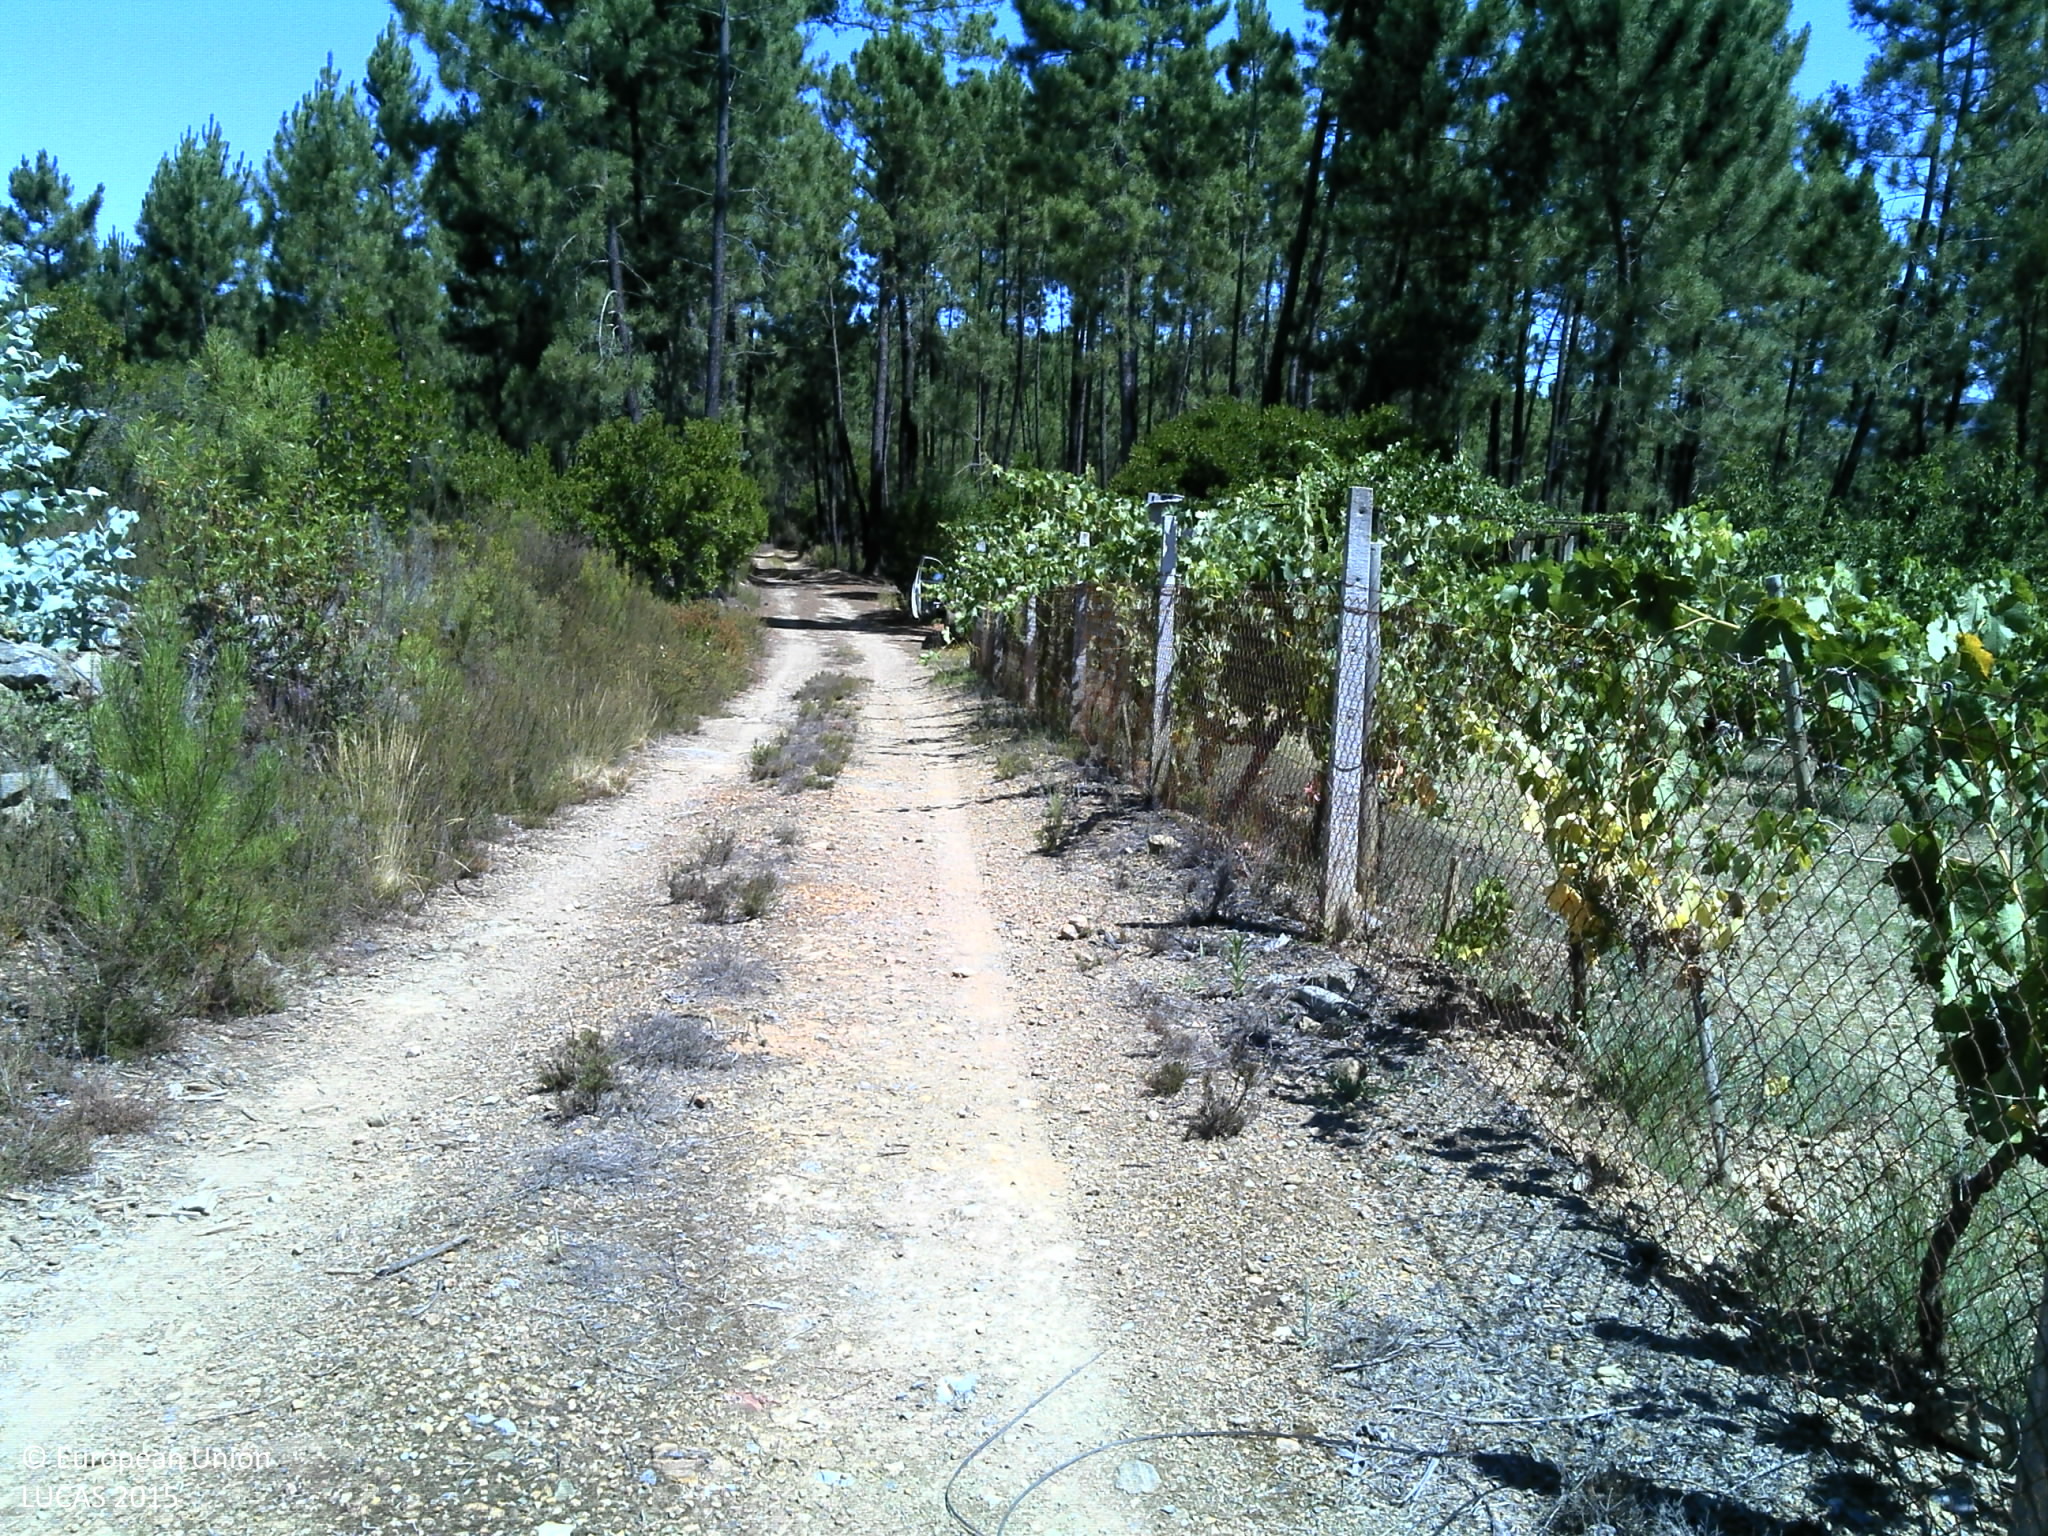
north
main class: Cropland
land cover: Vineyards
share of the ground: 25 - 50 %
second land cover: Grassland without tree/shrub cover
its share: 10 - 25 %
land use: Agriculture (excluding fallow land and kitchen gardens)
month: July
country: PT
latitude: 39.8257
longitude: -8.0955
